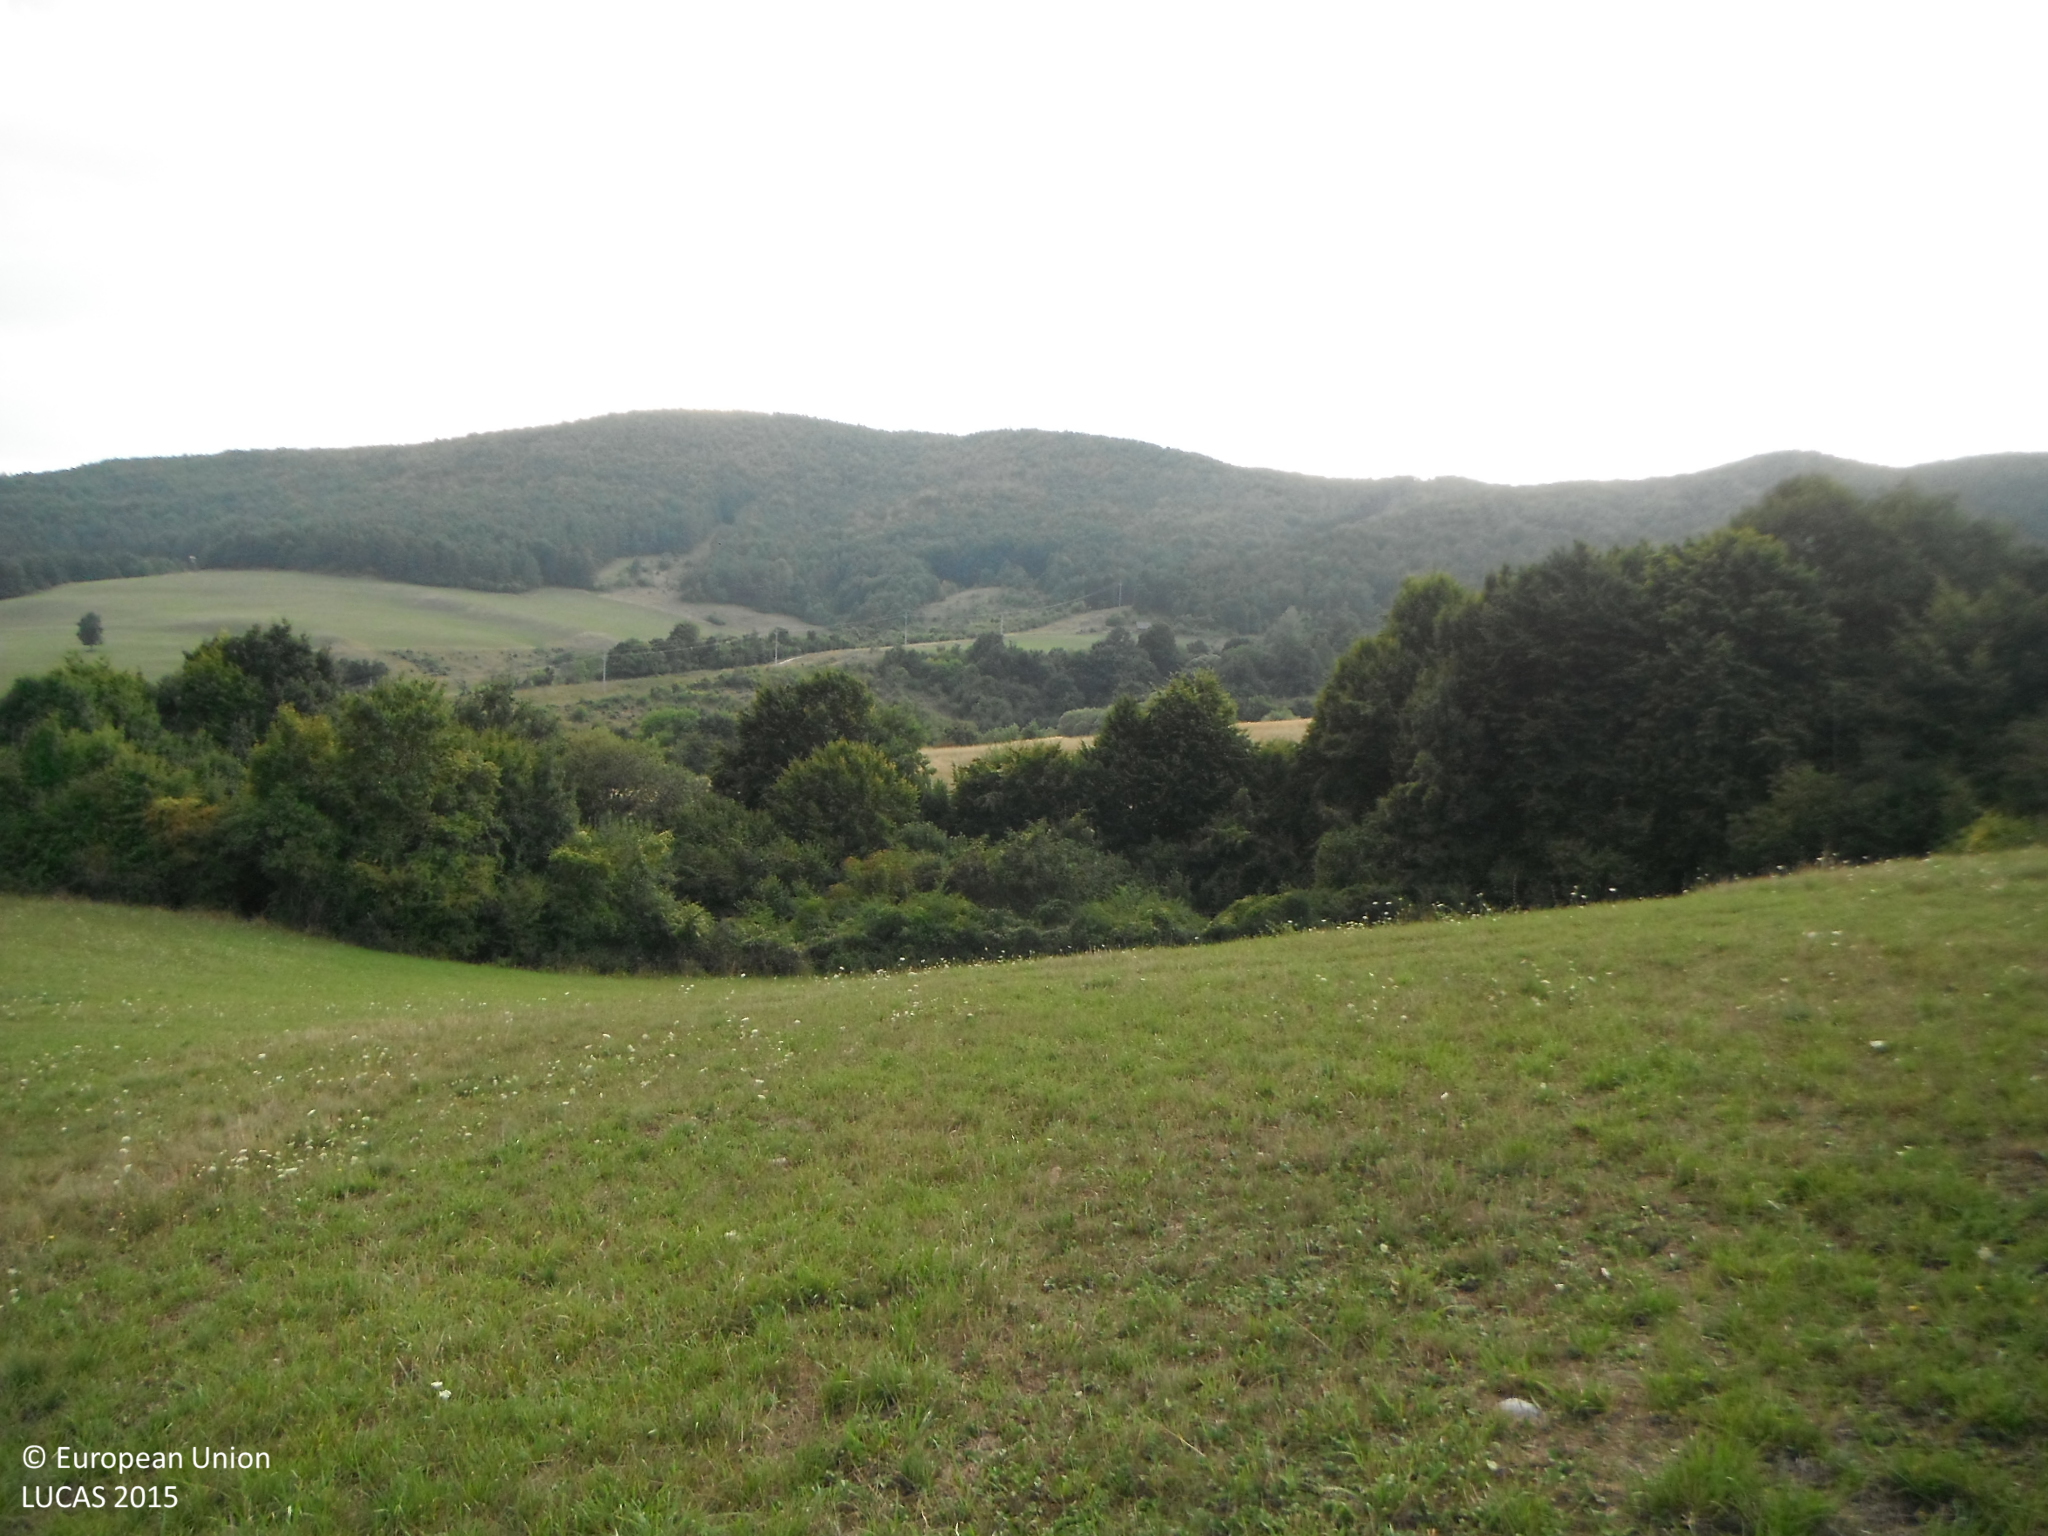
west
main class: Grassland
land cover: Grassland without tree/shrub cover
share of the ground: > 75 %
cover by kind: herbaceous plants 100 %
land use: Agriculture (excluding fallow land and kitchen gardens)
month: August
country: SK
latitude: 48.8117
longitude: 18.3366
